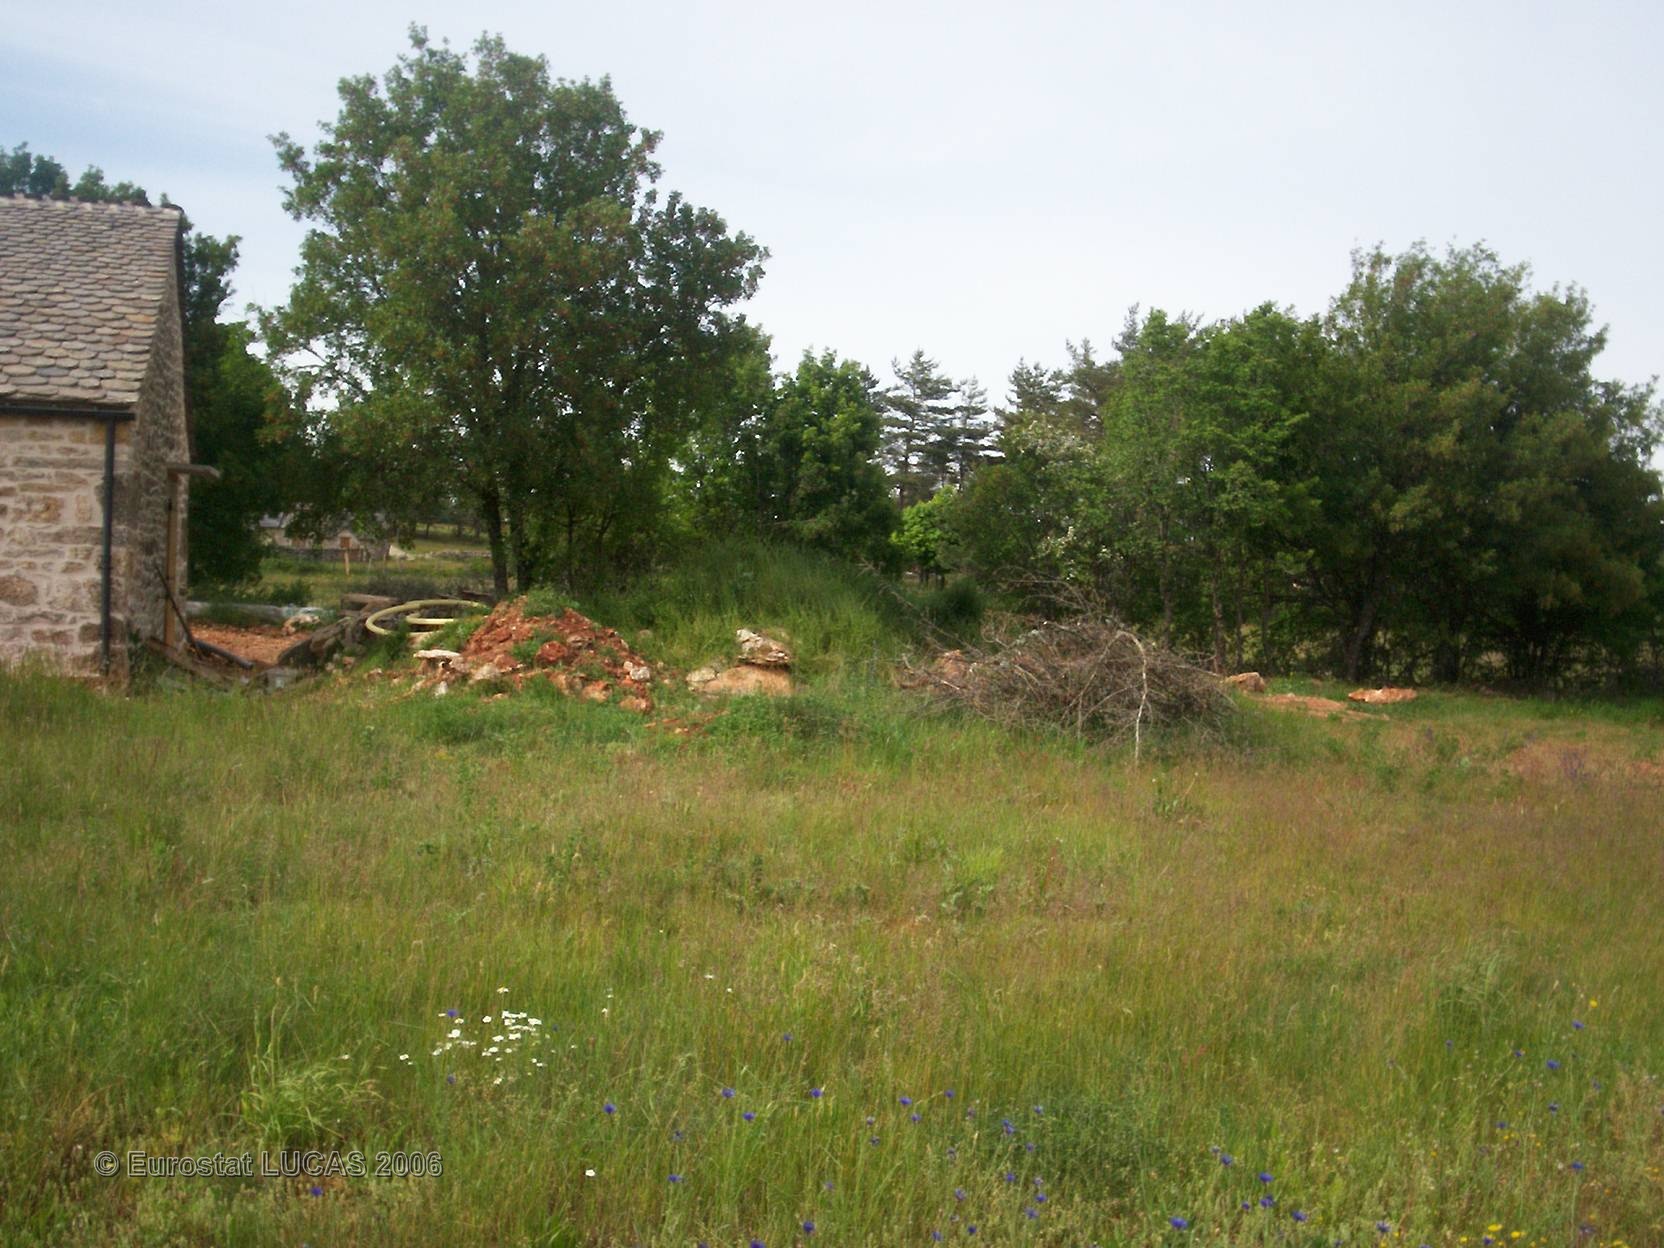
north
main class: Grassland
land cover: Grassland without tree/shrub cover
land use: Agriculture (excluding fallow land and kitchen gardens)
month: June
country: FR
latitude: 44.4680
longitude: 3.4311
